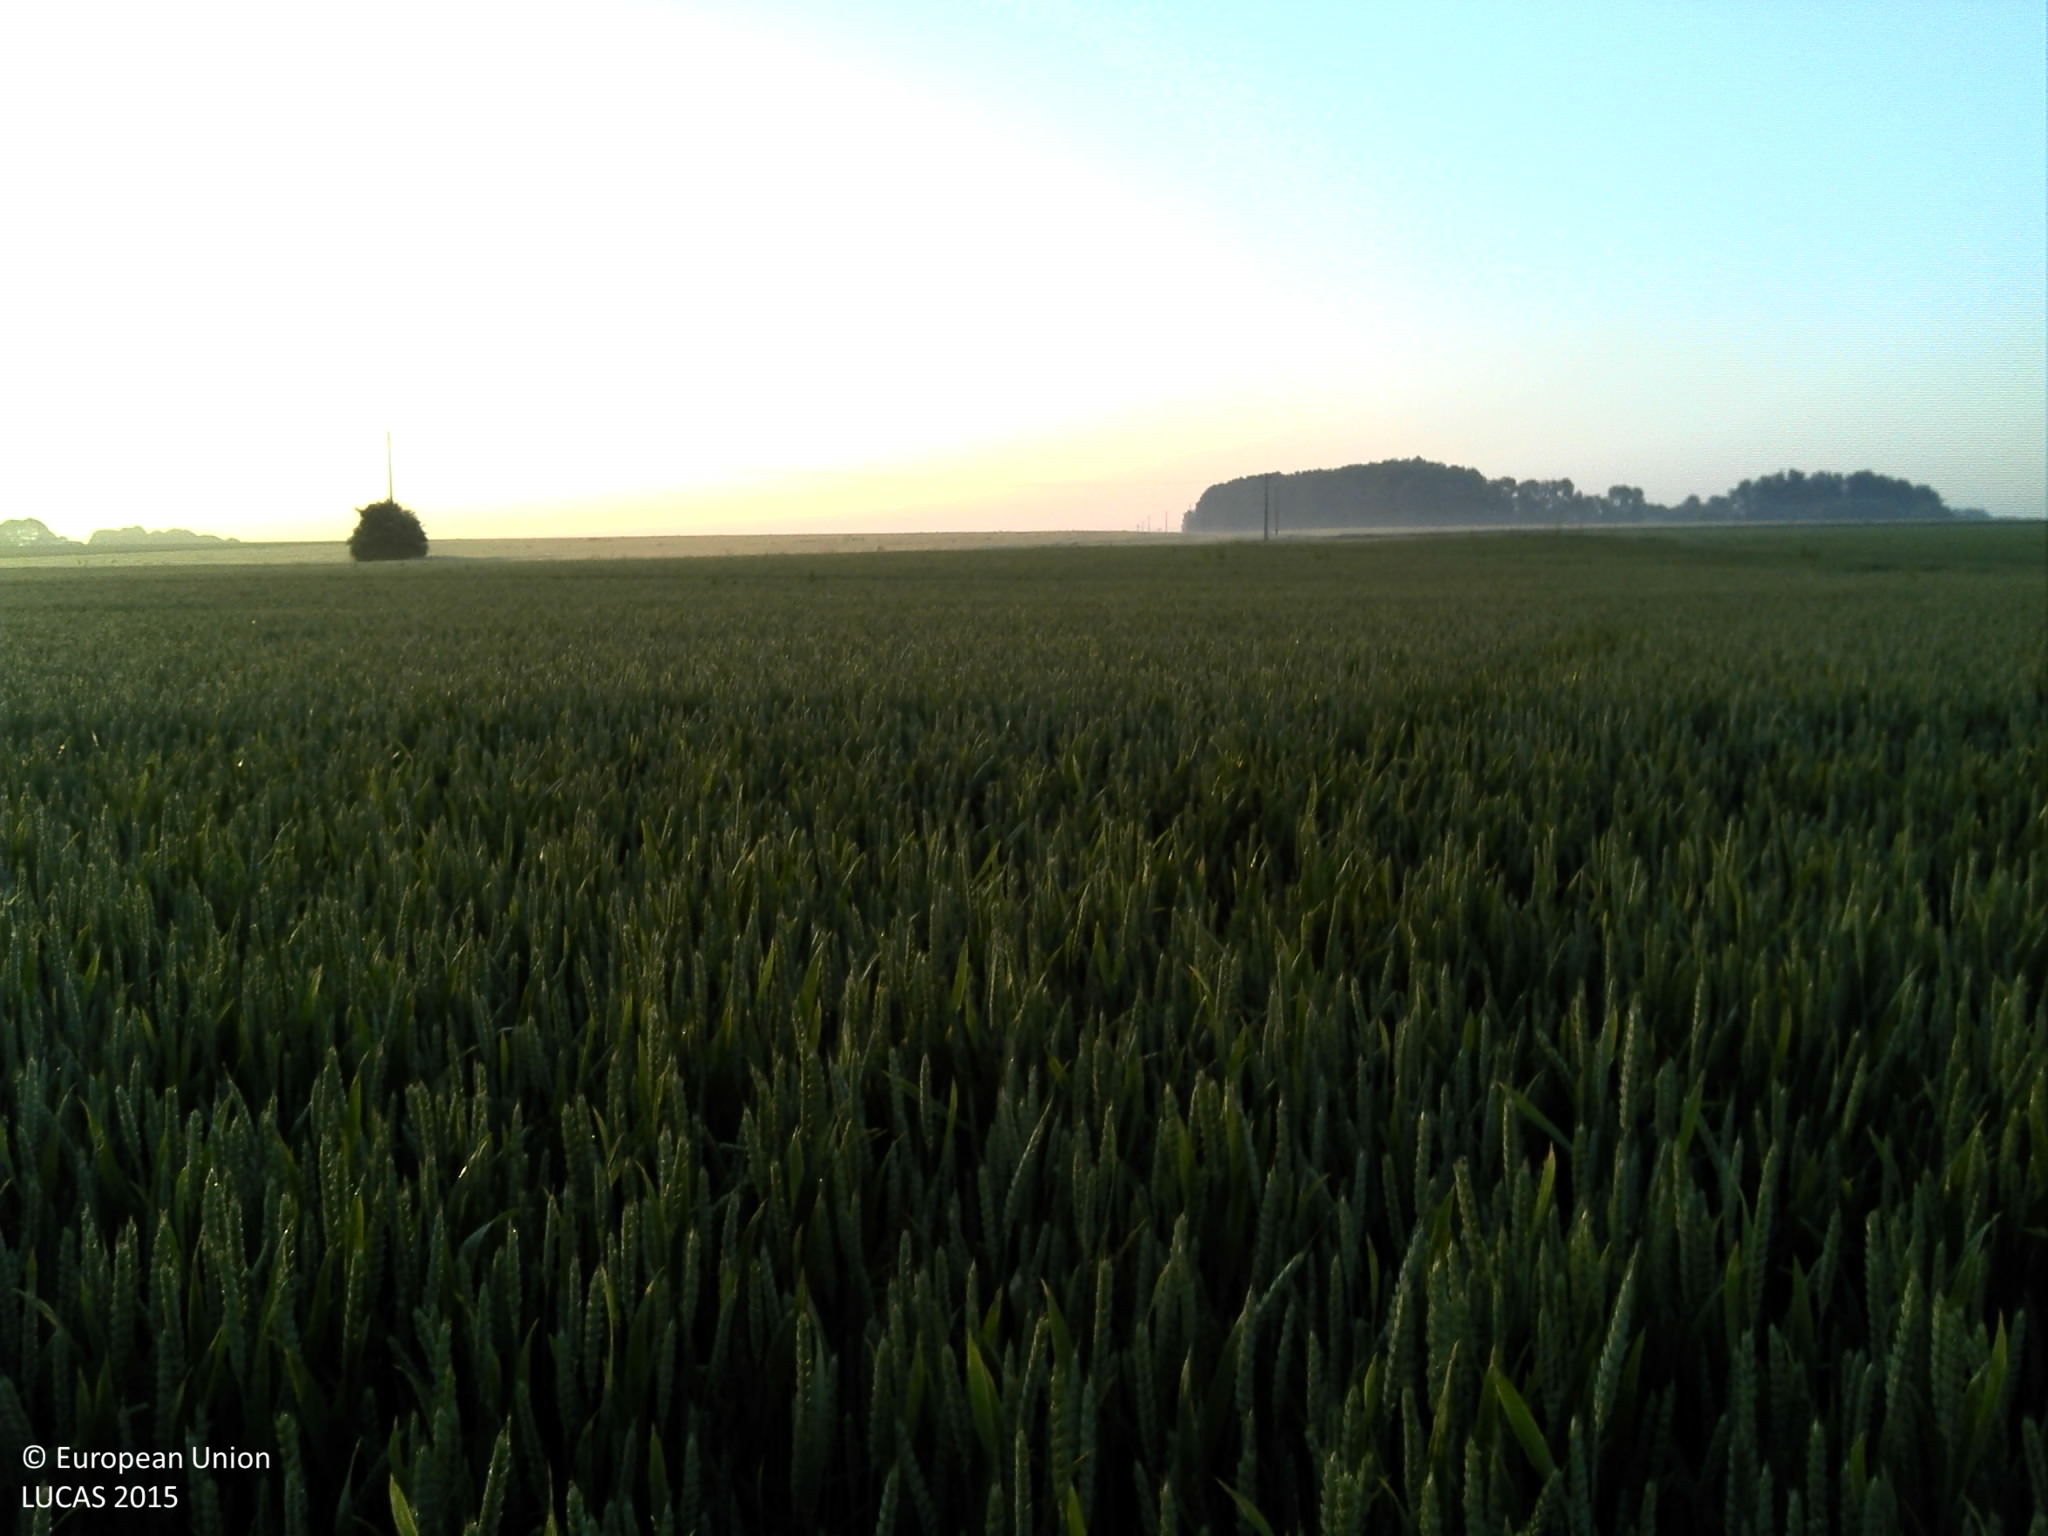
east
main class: Cropland
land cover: Common wheat
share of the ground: > 75 %
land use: Agriculture (excluding fallow land and kitchen gardens)
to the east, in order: Common wheat; Durum wheat; Electric lines; Durum wheat
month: June
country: FR
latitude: 49.5330
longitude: 0.2853
